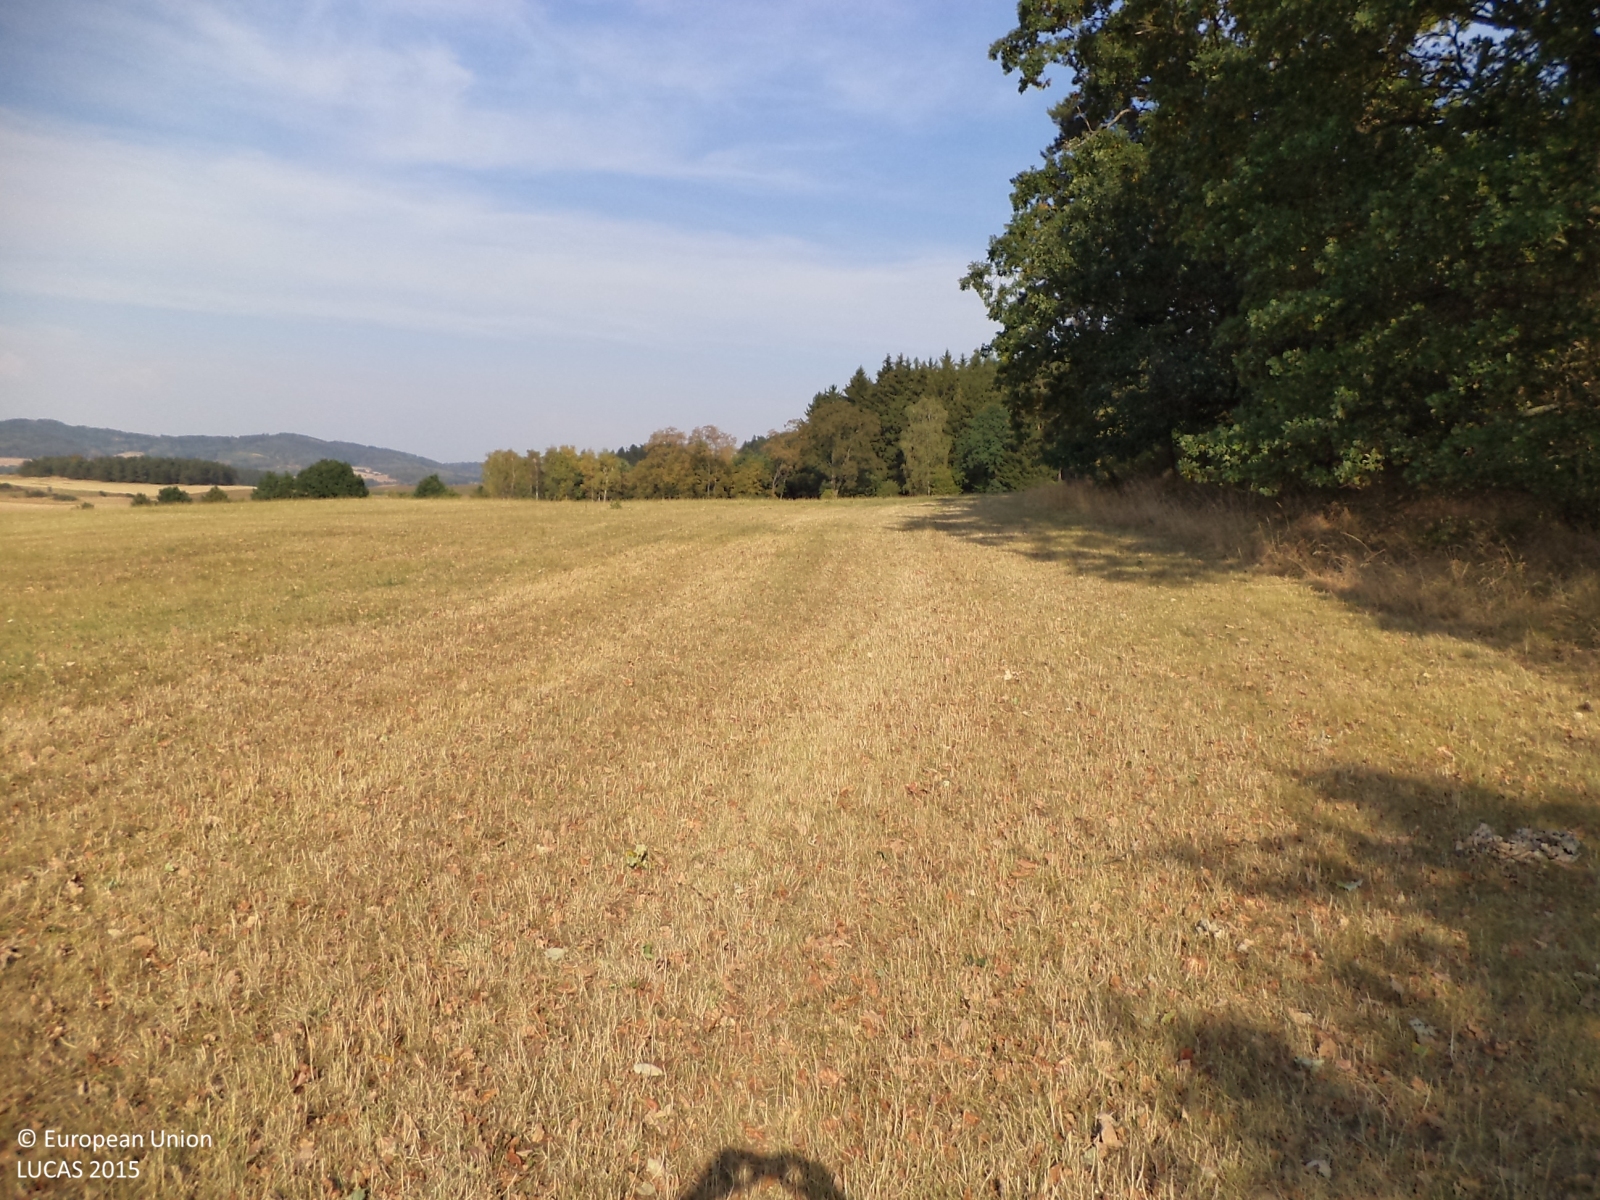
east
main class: Grassland
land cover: Grassland without tree/shrub cover
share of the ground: > 75 %
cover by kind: herbaceous plants 100 %
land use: Agriculture (excluding fallow land and kitchen gardens)
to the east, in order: Grassland without tree/shrub cover; Other mixed woodland; Tracks; Spruce dominated coniferous woodland
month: August
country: CZ
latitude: 49.5934
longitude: 14.4423
